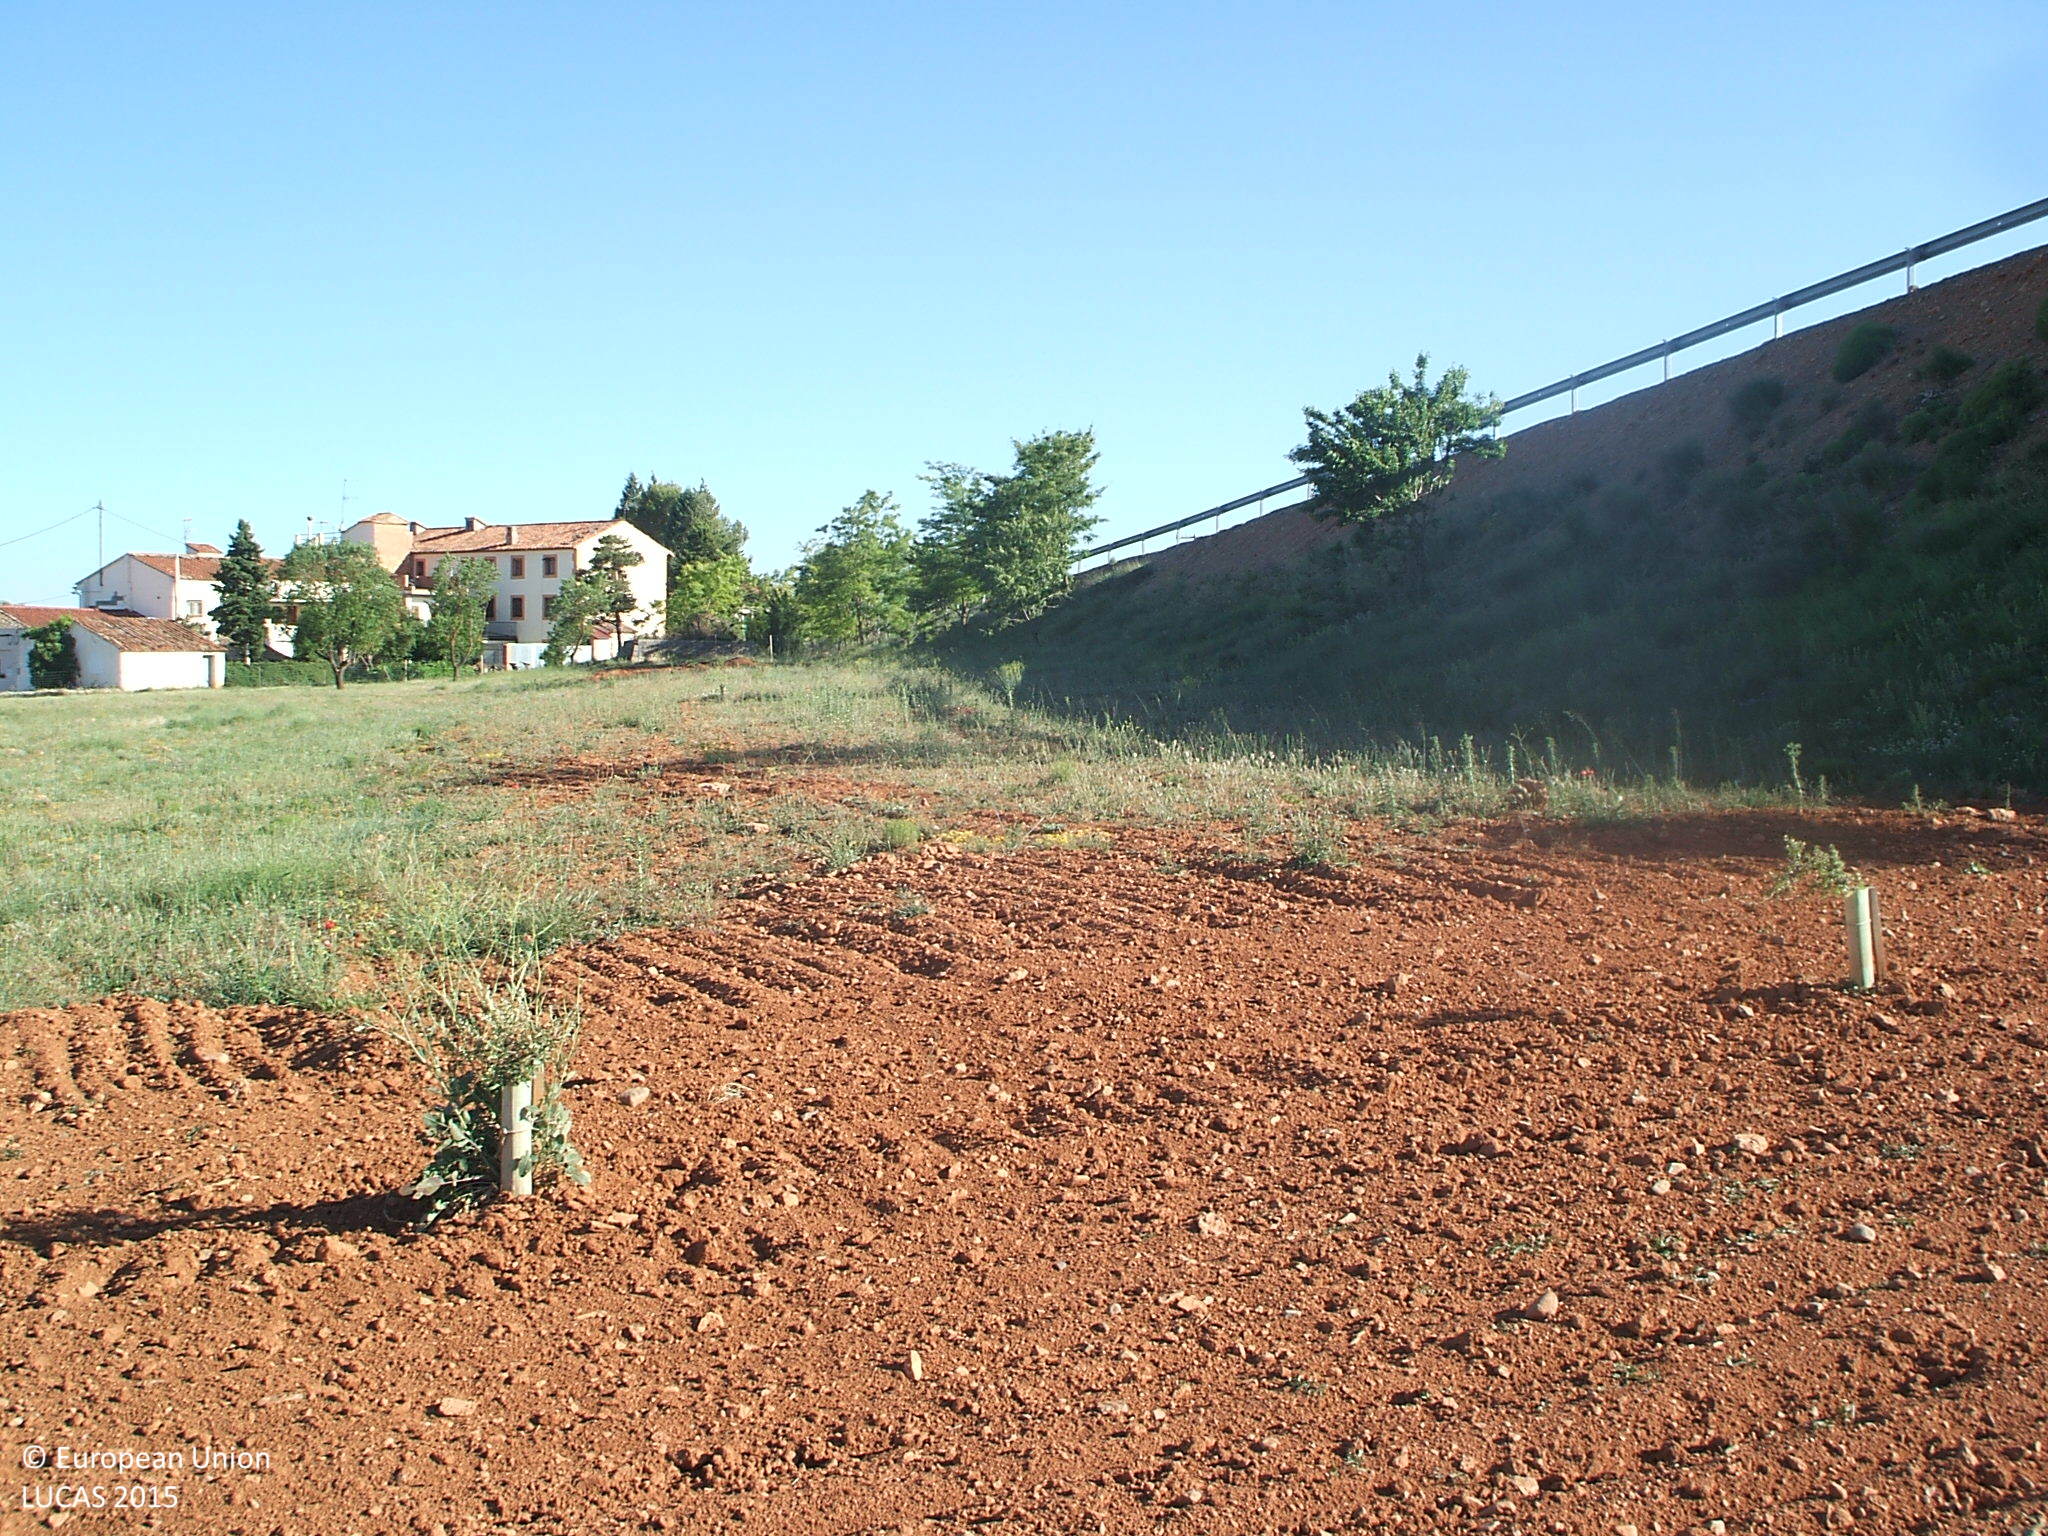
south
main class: Woodland
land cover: Broadleaved woodland
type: broadleaved evergreen forest
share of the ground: 10 - 25 %
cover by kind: unconsolidated bare surface 85 %, broadleaved forest trees 15 %
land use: Forestry
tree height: < 5 m
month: May
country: ES
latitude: 40.1136
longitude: -0.7413
